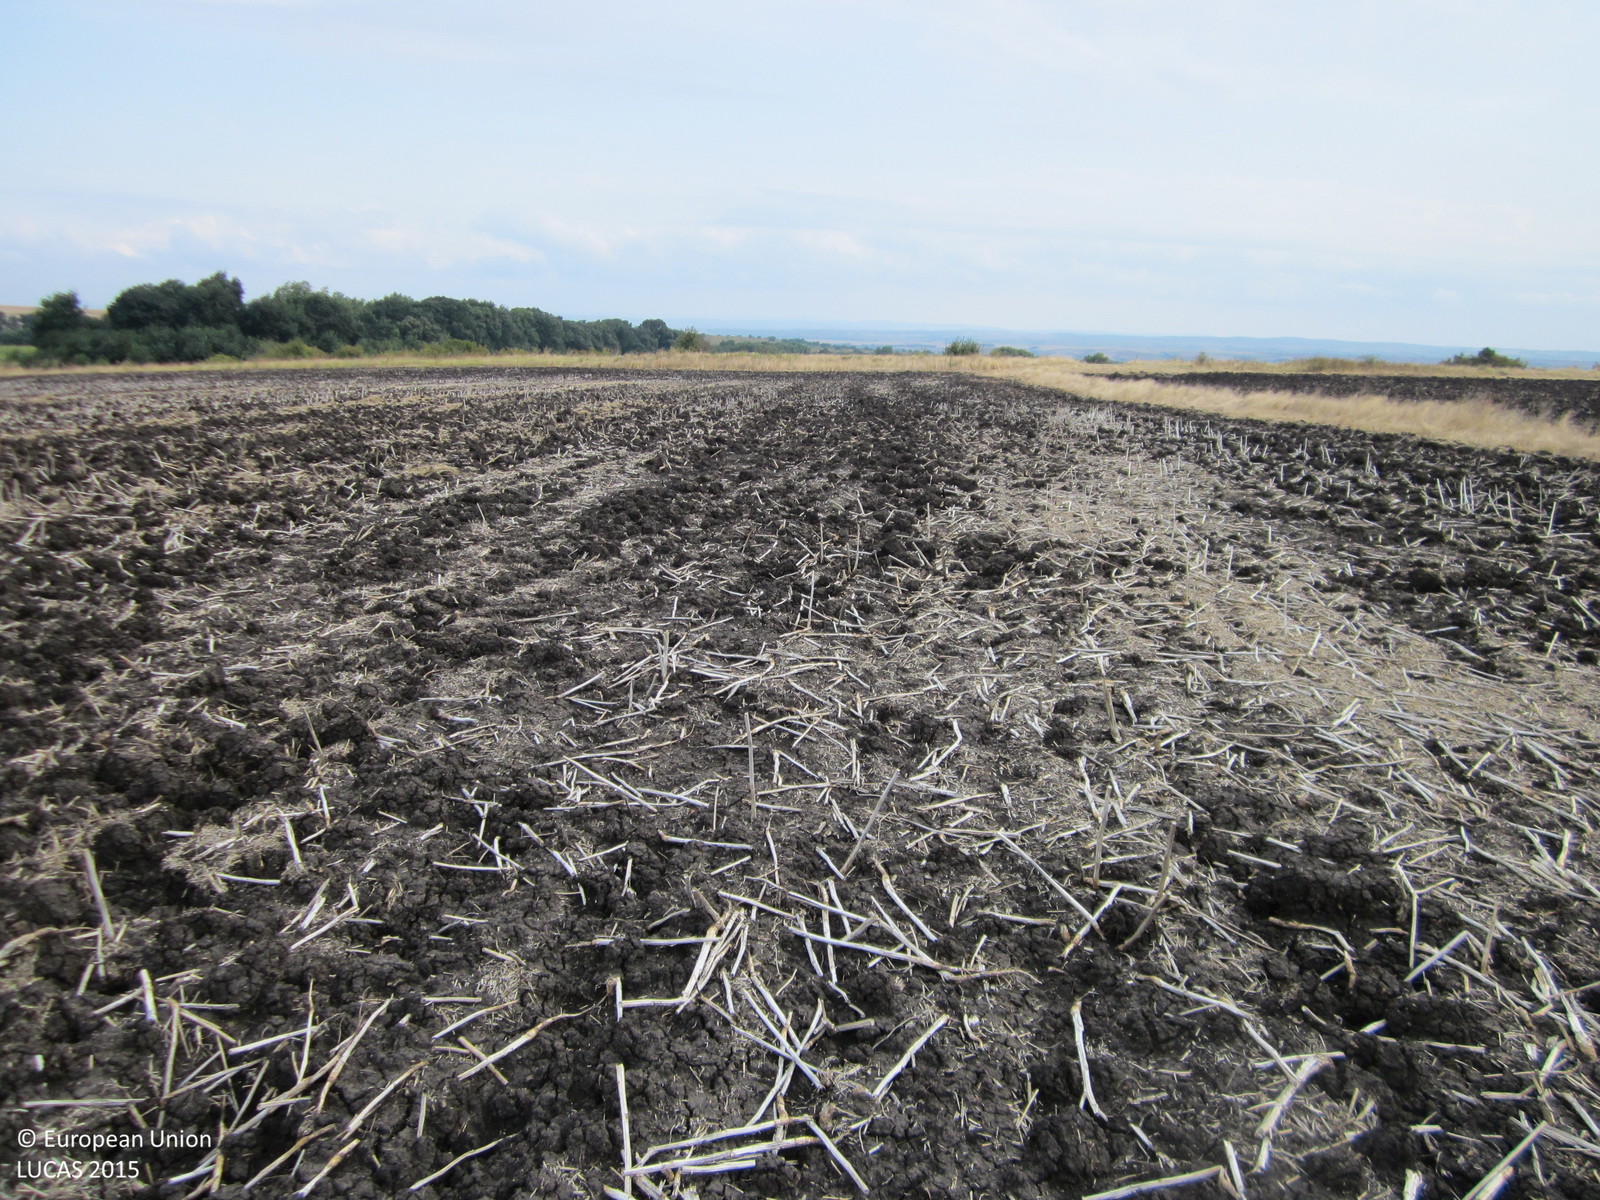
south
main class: Cropland
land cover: Sunflower
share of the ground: 10 - 25 %
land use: Agriculture (excluding fallow land and kitchen gardens)
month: August
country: BG
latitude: 42.4575
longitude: 26.9946
